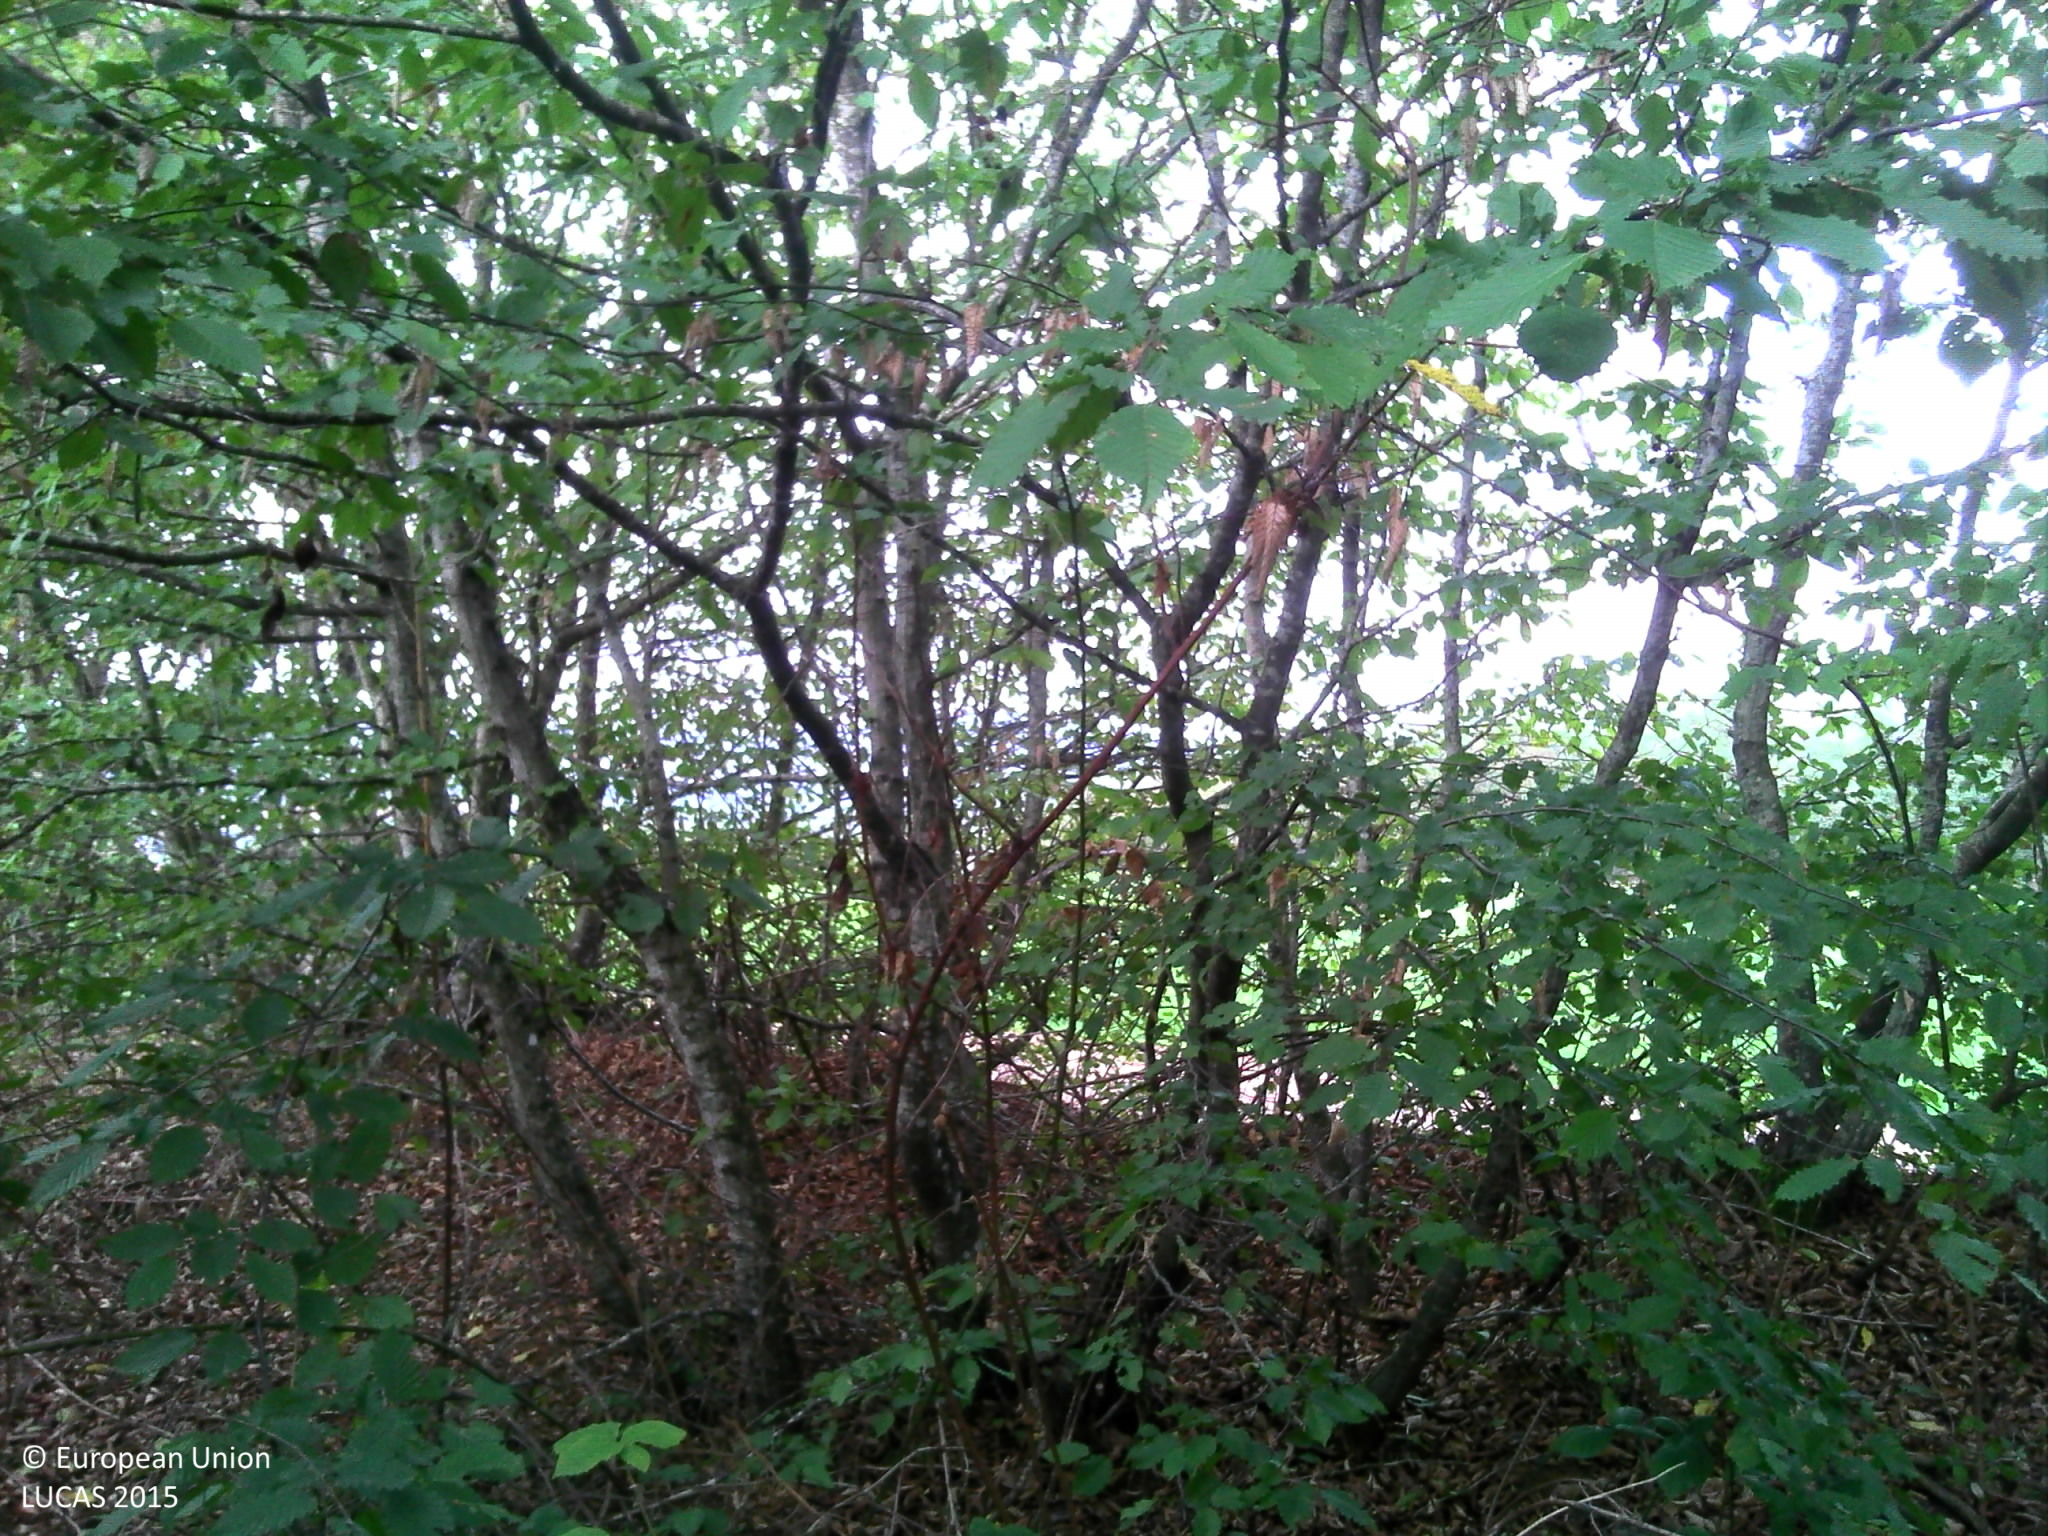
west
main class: Woodland
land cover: Broadleaved woodland
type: mesophytic deciduous forest
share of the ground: > 75 %
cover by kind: broadleaved forest trees 80 %, shrubs 20 %
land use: Forestry
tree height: < 5 m
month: September
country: FR
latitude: 47.1429
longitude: 4.3955
